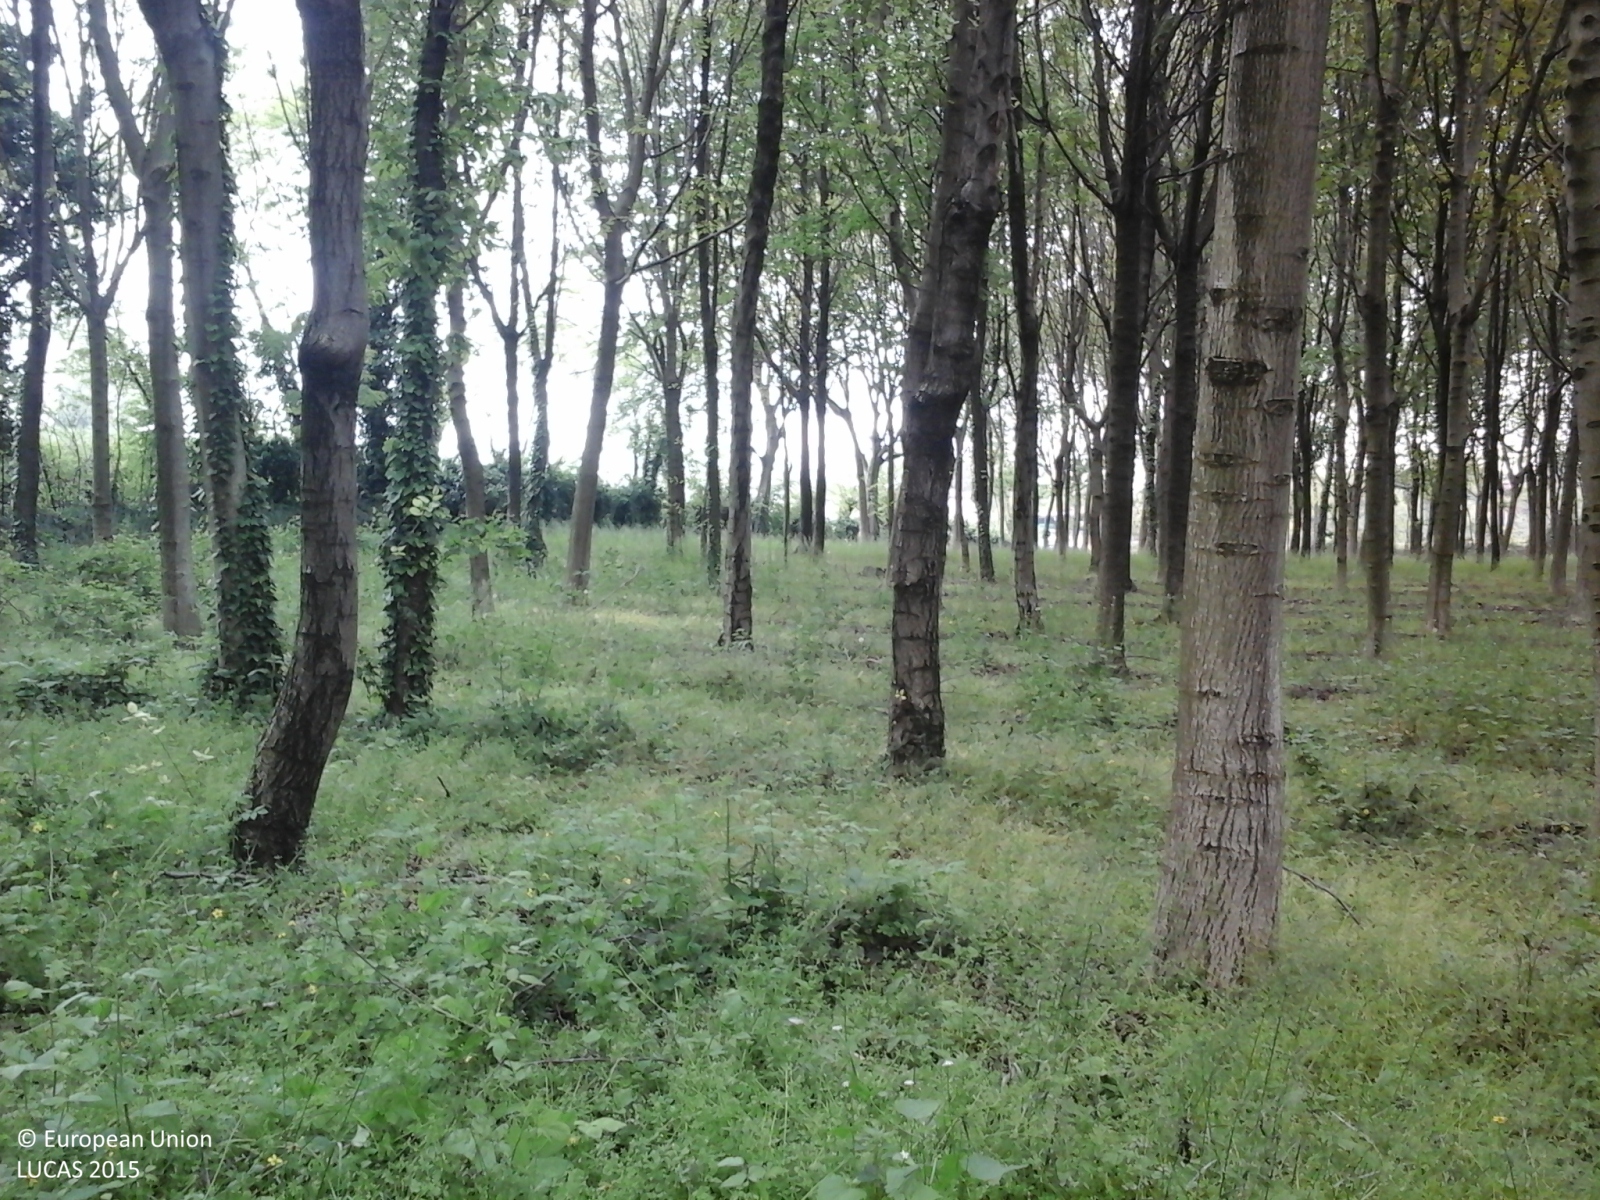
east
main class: Woodland
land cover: Broadleaved woodland
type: non-riverine alder, birch or aspen forest
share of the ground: > 75 %
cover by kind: broadleaved forest trees 100 %
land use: Forestry
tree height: > 5 m
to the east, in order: Broadleaved woodland; Grass margins; Managed hedges; Fences; Temporary grasslands; Electric lines; Grass margins; Paved roads, cycling and walking lanes; Grass margins; Ditches and canals; Grass margins; Artificial constructions in urban areas
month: April
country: IT
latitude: 45.3587
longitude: 10.5734
